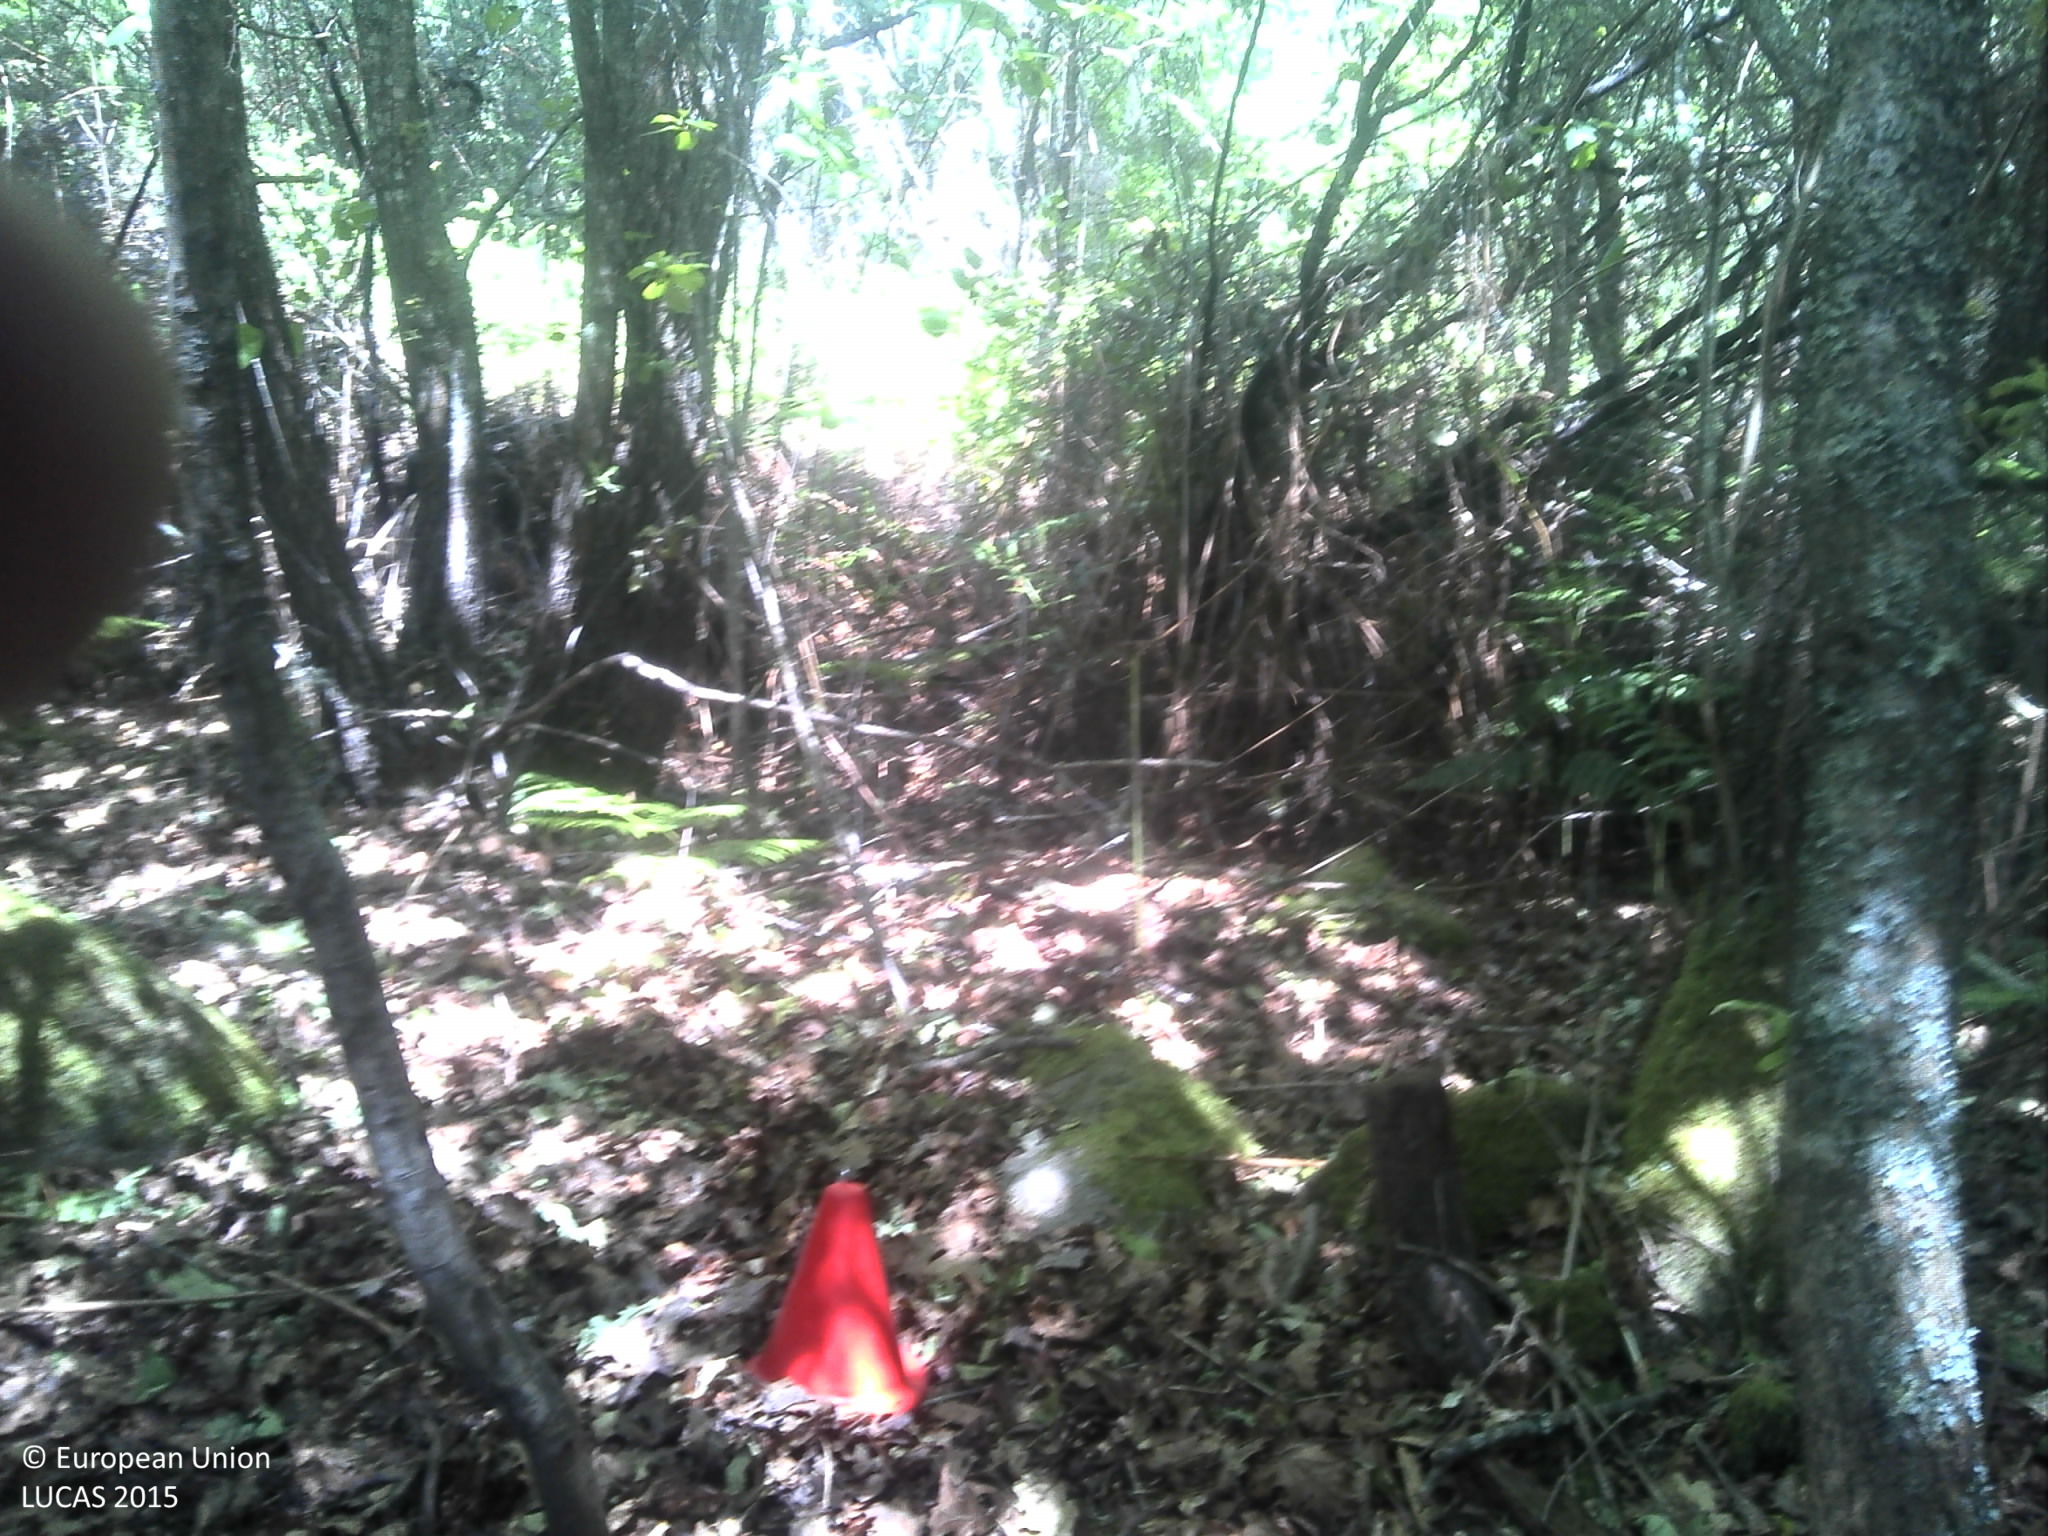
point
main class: Woodland
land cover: Broadleaved woodland
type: acidophilous oak and oak-birch forest
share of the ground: > 75 %
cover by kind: broadleaved forest trees 80 %, coniferous forest trees 10 %, shrubs 10 %
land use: Forestry
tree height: > 5 m
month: May
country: PT
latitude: 40.7040
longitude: -7.8413
